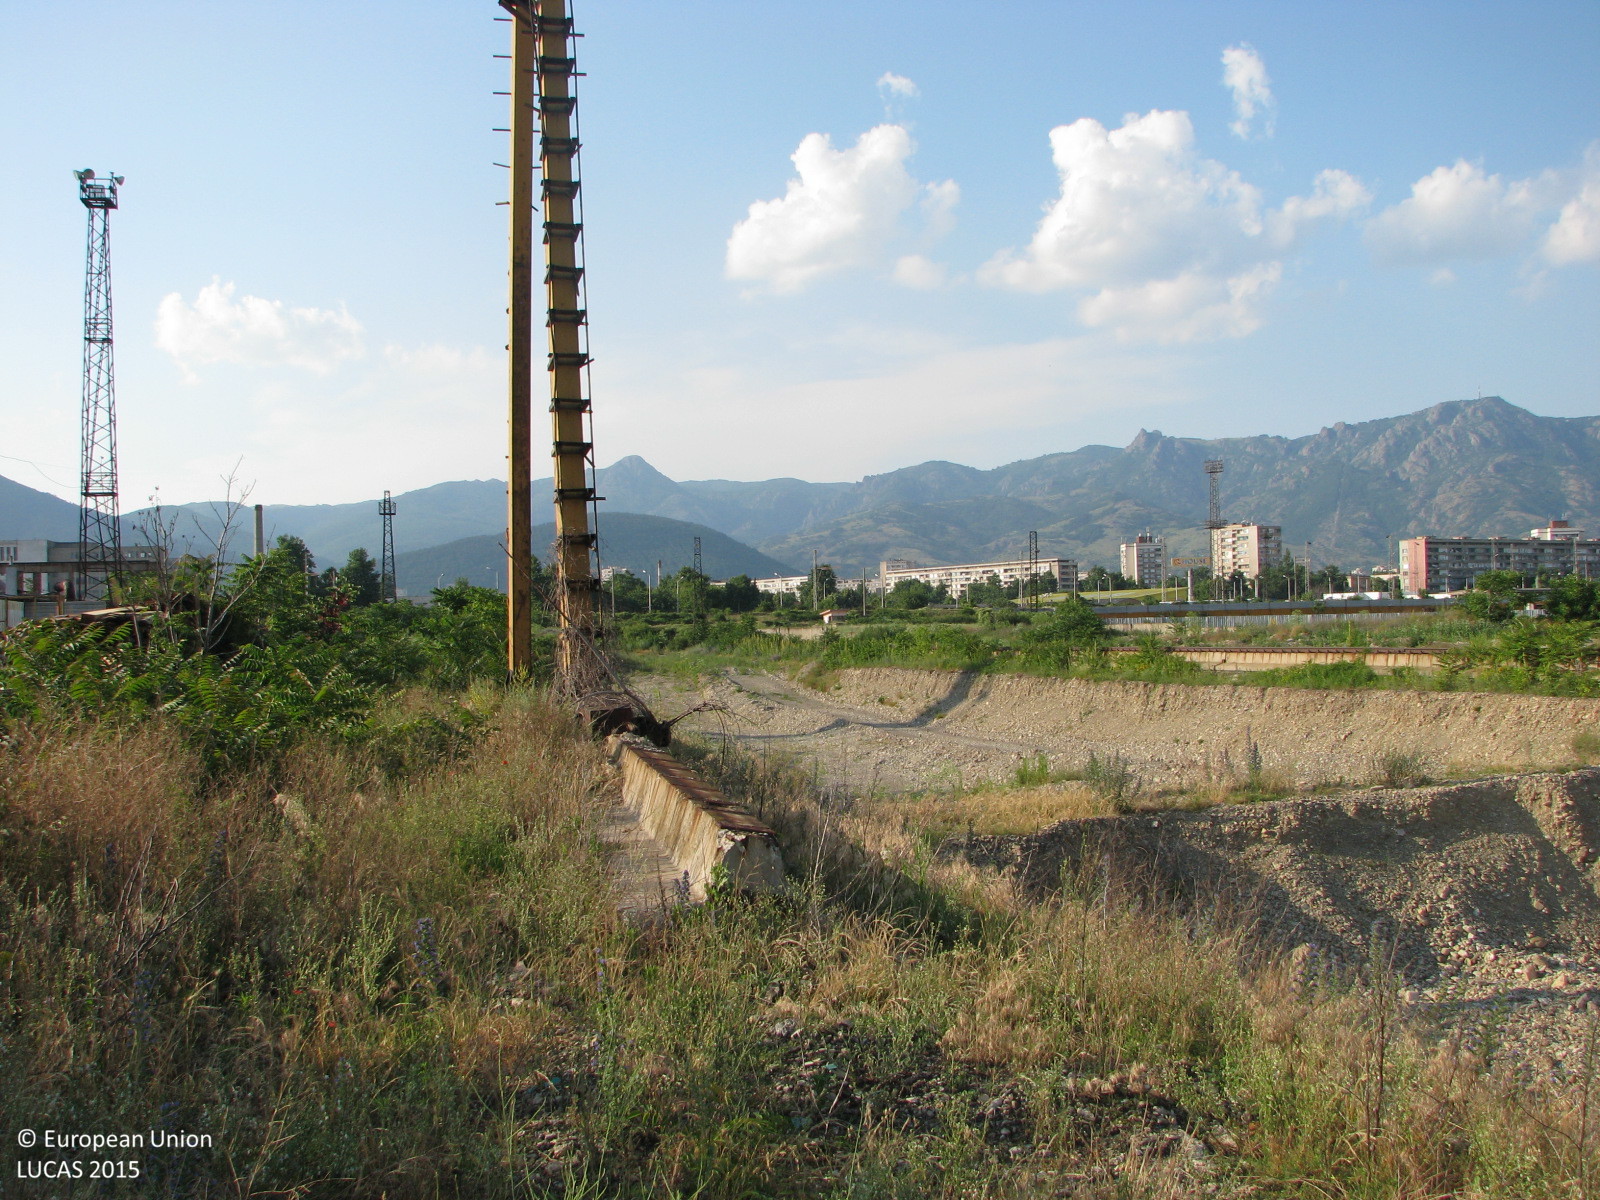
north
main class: Grassland
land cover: Grassland with sparse tree/shrub cover
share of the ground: > 75 %
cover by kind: herbaceous plants 90 %, broadleaved forest trees 5 %, shrubs 5 %
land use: Abandoned areas
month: June
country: BG
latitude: 42.6607
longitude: 26.3283
